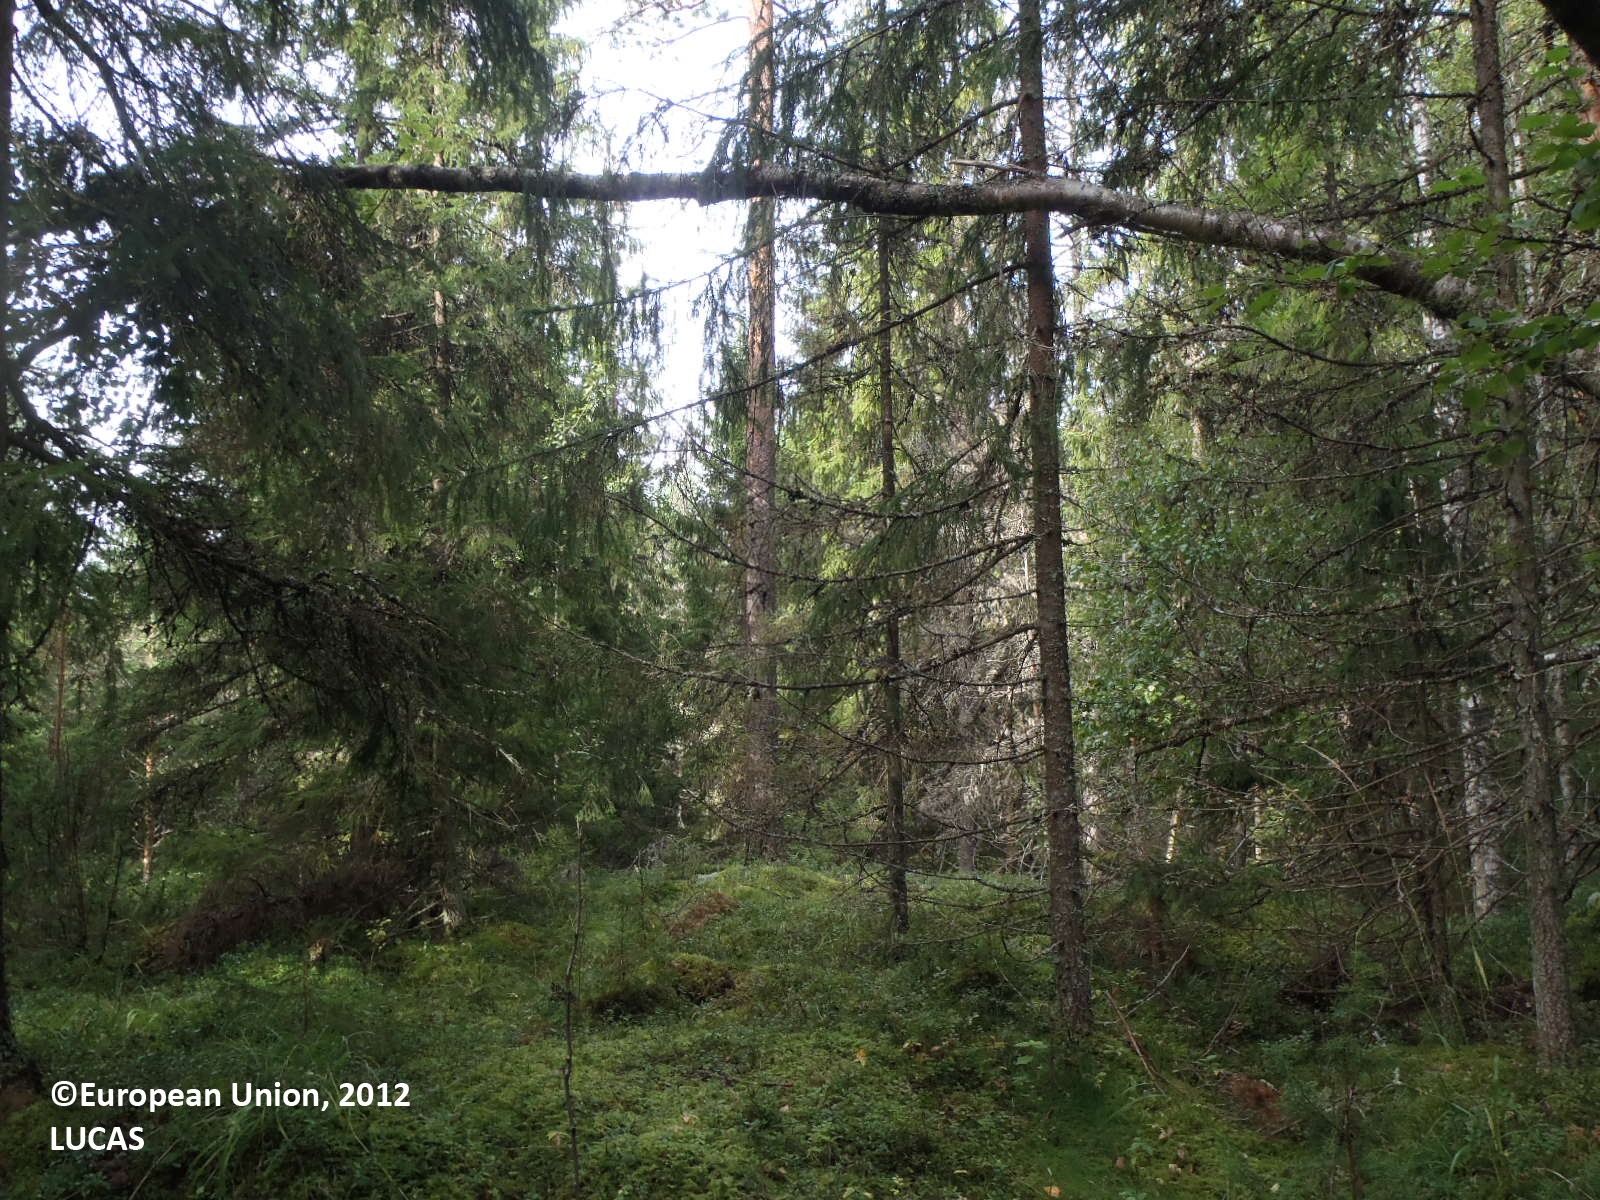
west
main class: Woodland
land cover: Spruce dominated coniferous woodland
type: boreal forest
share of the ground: 50 - 75 %
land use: Forestry
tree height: > 5 m
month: August
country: FI
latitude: 60.8093
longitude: 22.2884
